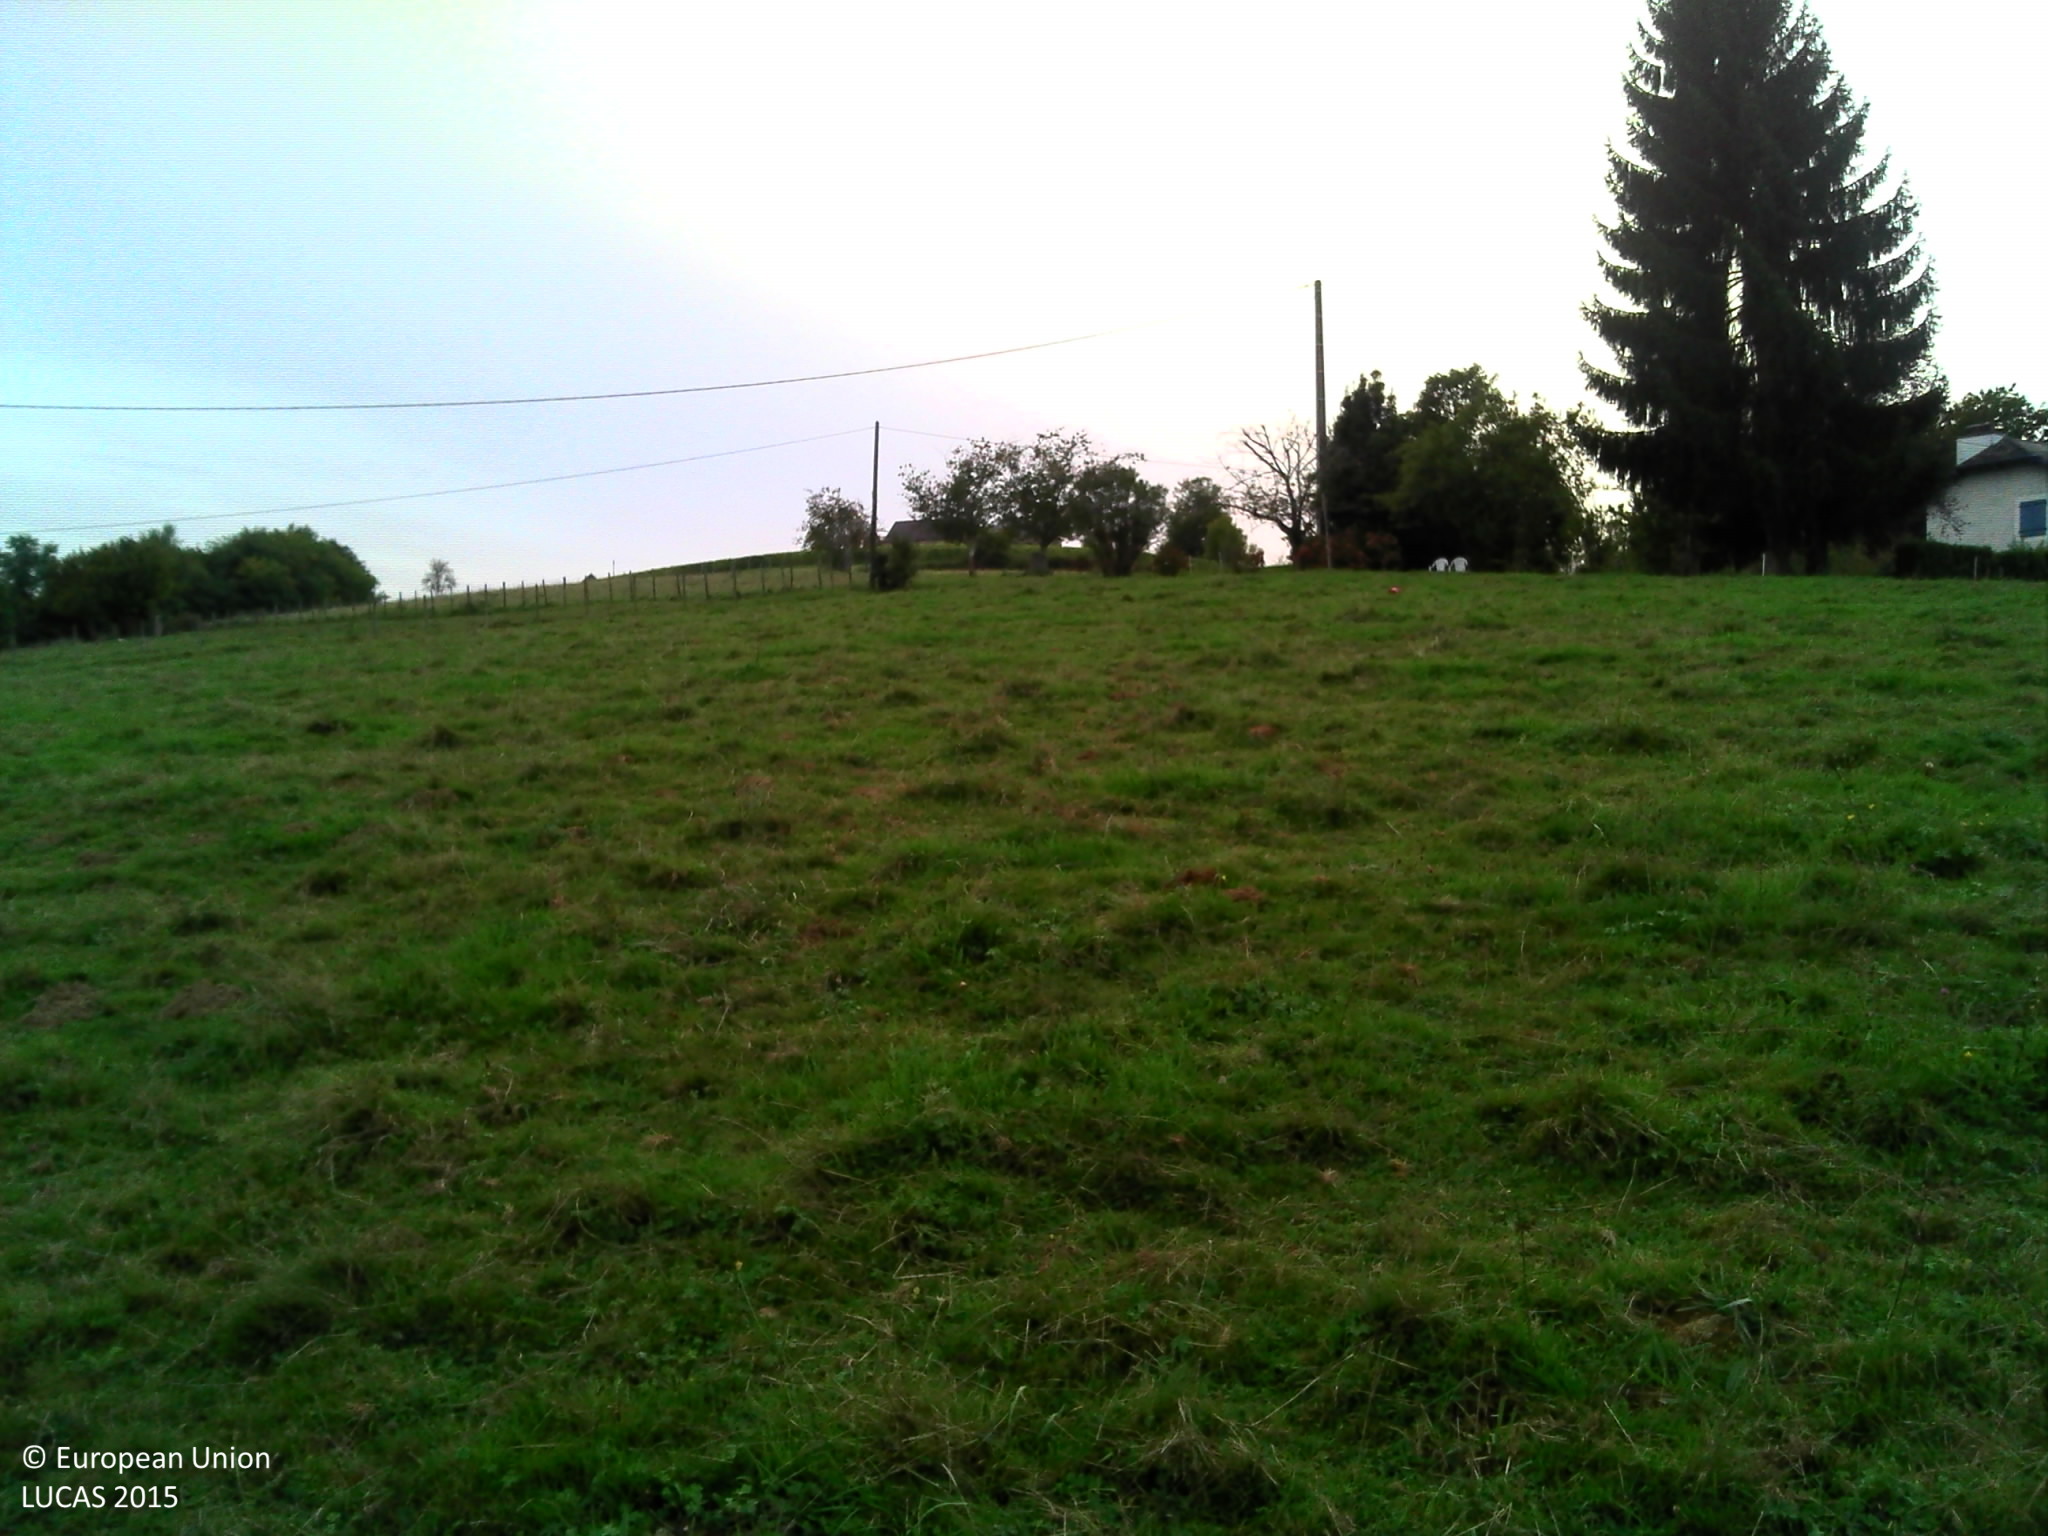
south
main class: Grassland
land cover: Grassland without tree/shrub cover
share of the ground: > 75 %
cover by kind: herbaceous plants 100 %
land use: Agriculture (excluding fallow land and kitchen gardens)
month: September
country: FR
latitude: 43.2614
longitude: -0.4165
